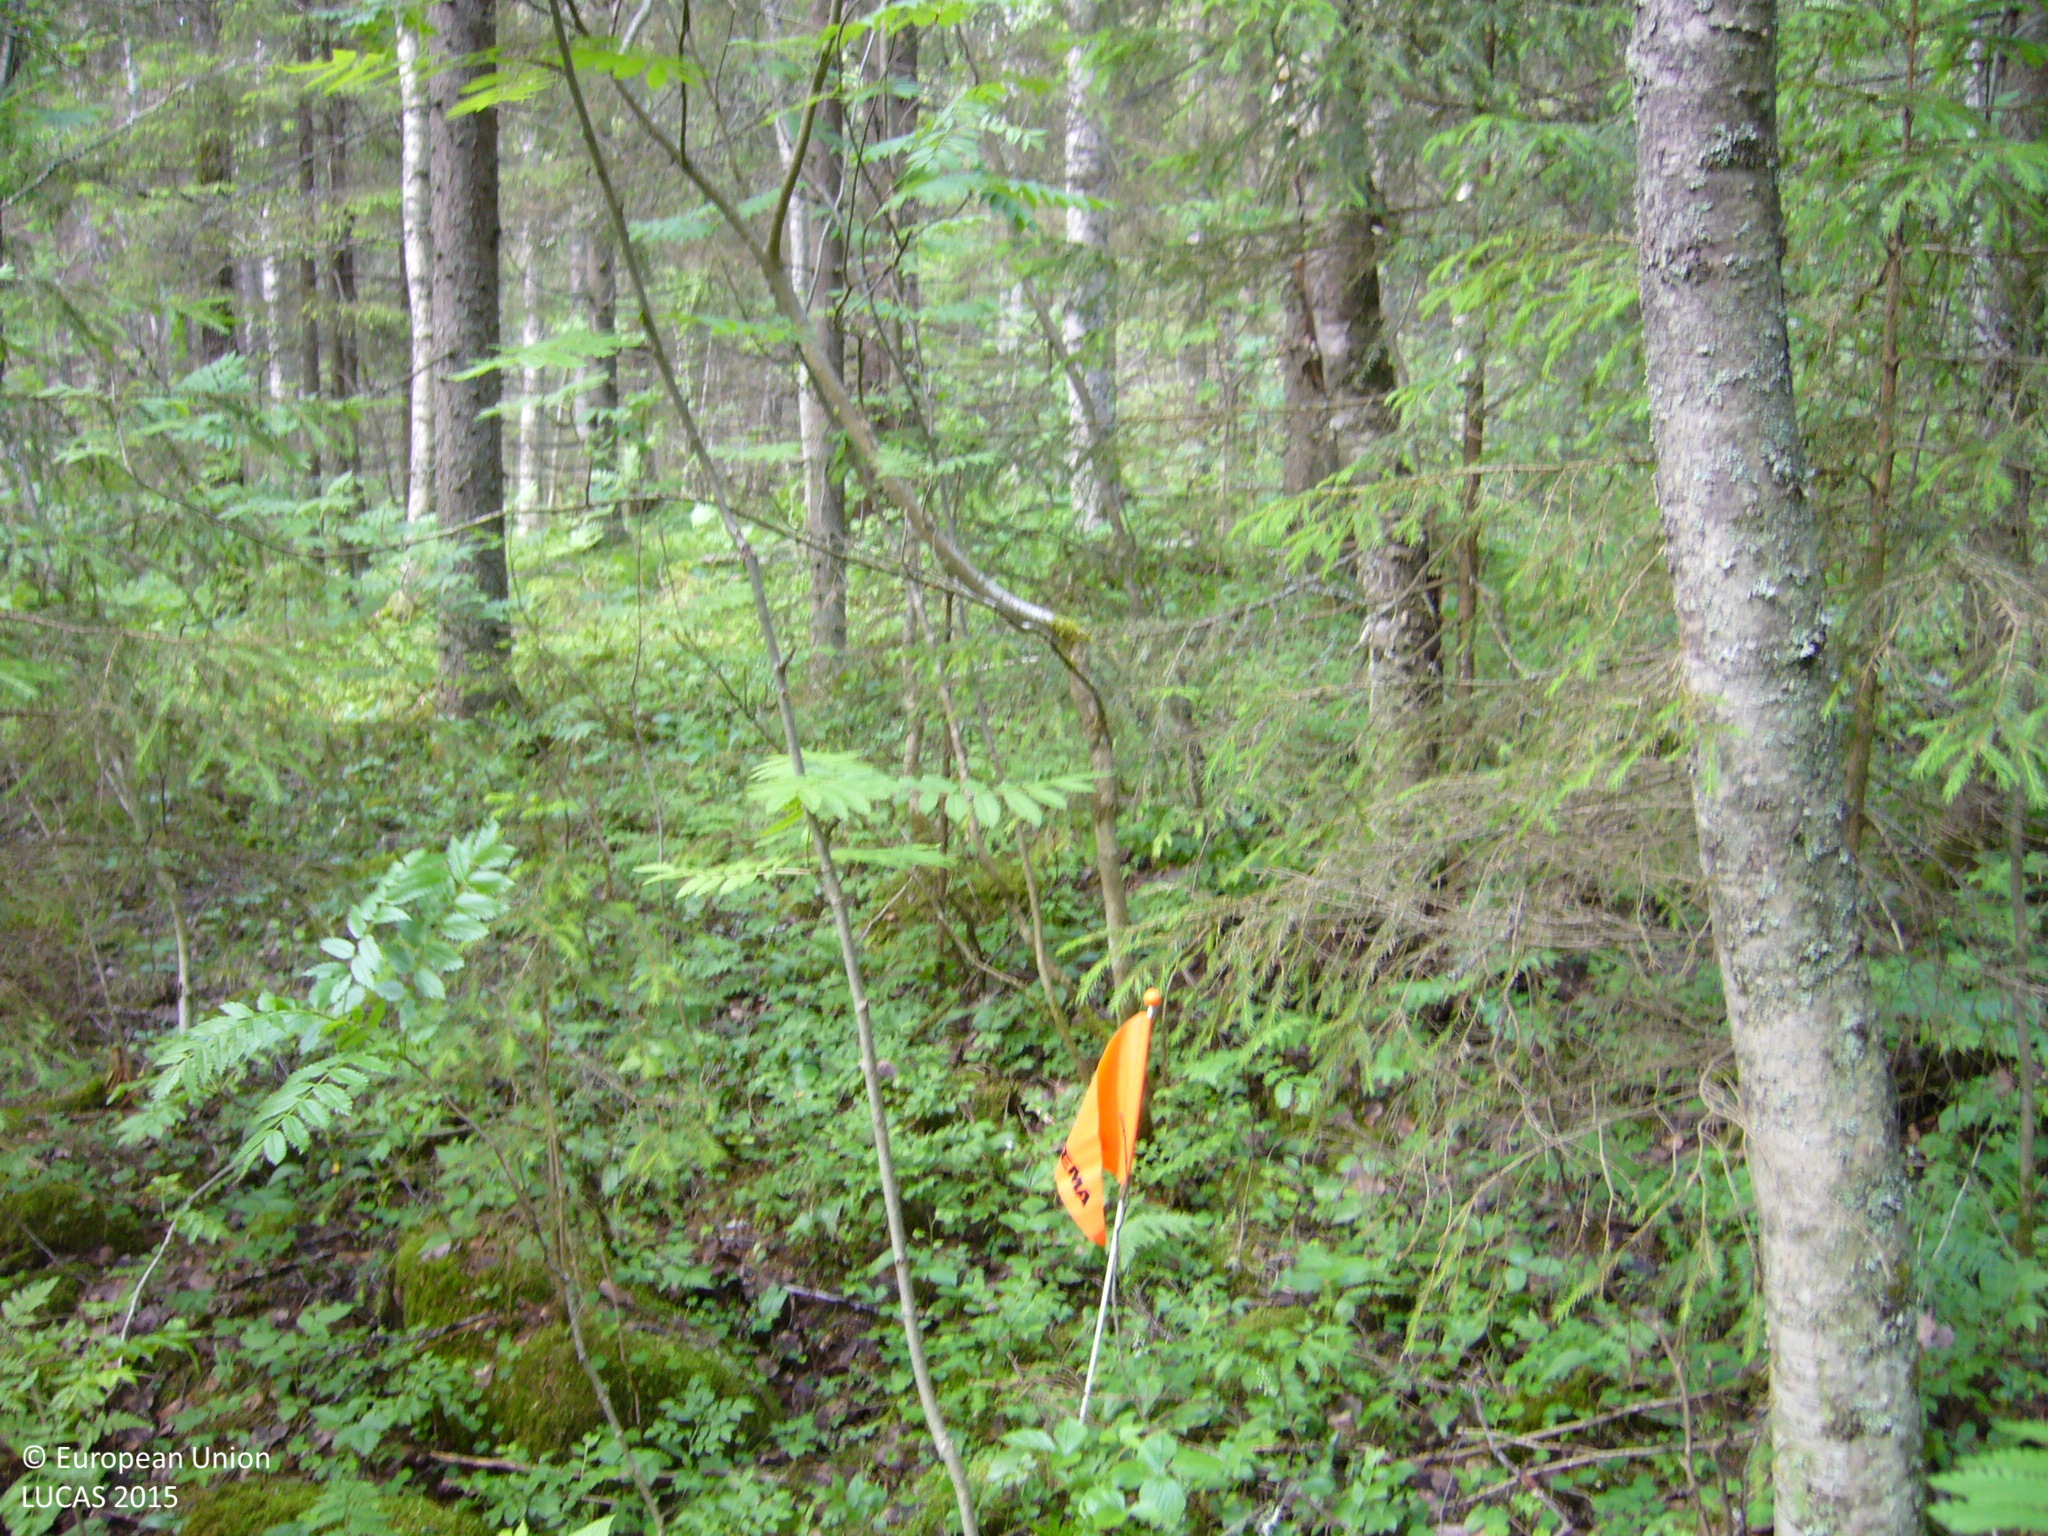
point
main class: Woodland
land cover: Spruce dominated mixed woodland
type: boreal forest
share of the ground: > 75 %
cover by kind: coniferous forest trees 60 %, broadleaved forest trees 30 %, shrubs 10 %
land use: Forestry
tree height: > 5 m
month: July
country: FI
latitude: 63.5089
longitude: 26.1318
